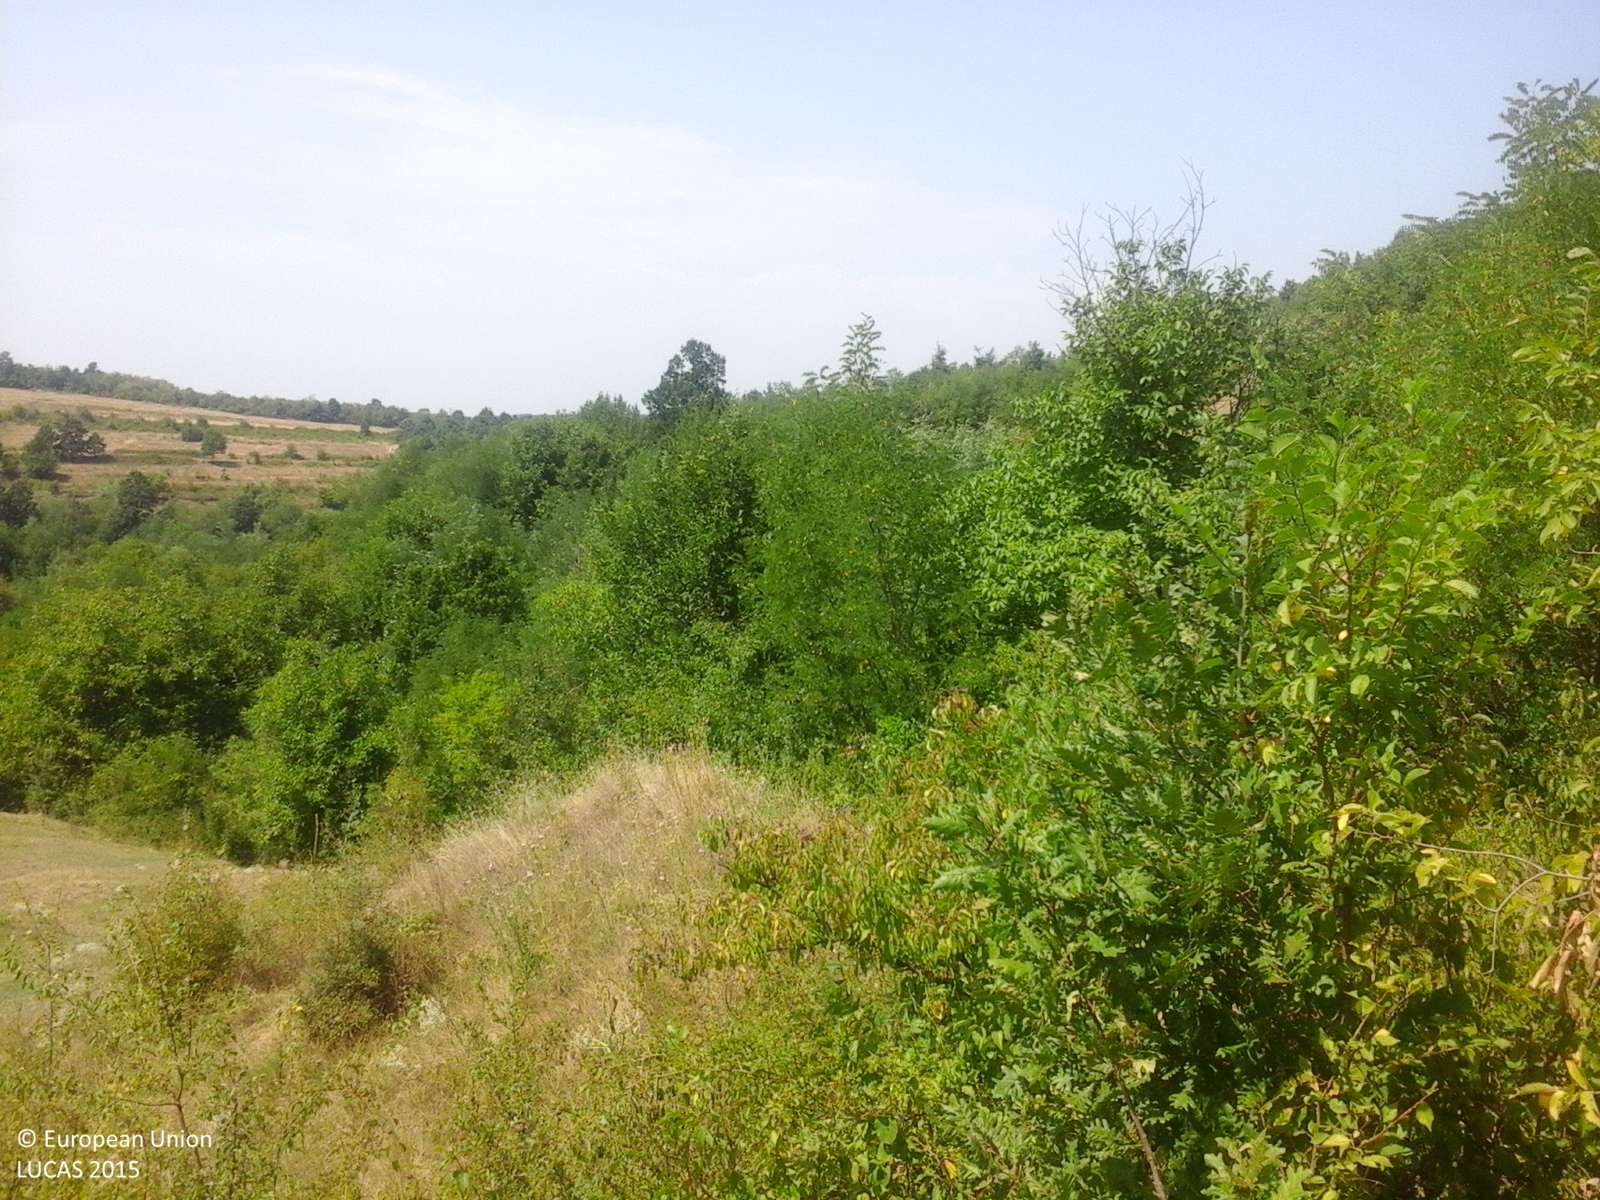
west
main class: Woodland
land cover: Broadleaved woodland
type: acidophilous oak and oak-birch forest
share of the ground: > 75 %
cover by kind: broadleaved forest trees 100 %
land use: Forestry
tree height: > 5 m
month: August
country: RO
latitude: 44.5801
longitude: 23.0568
